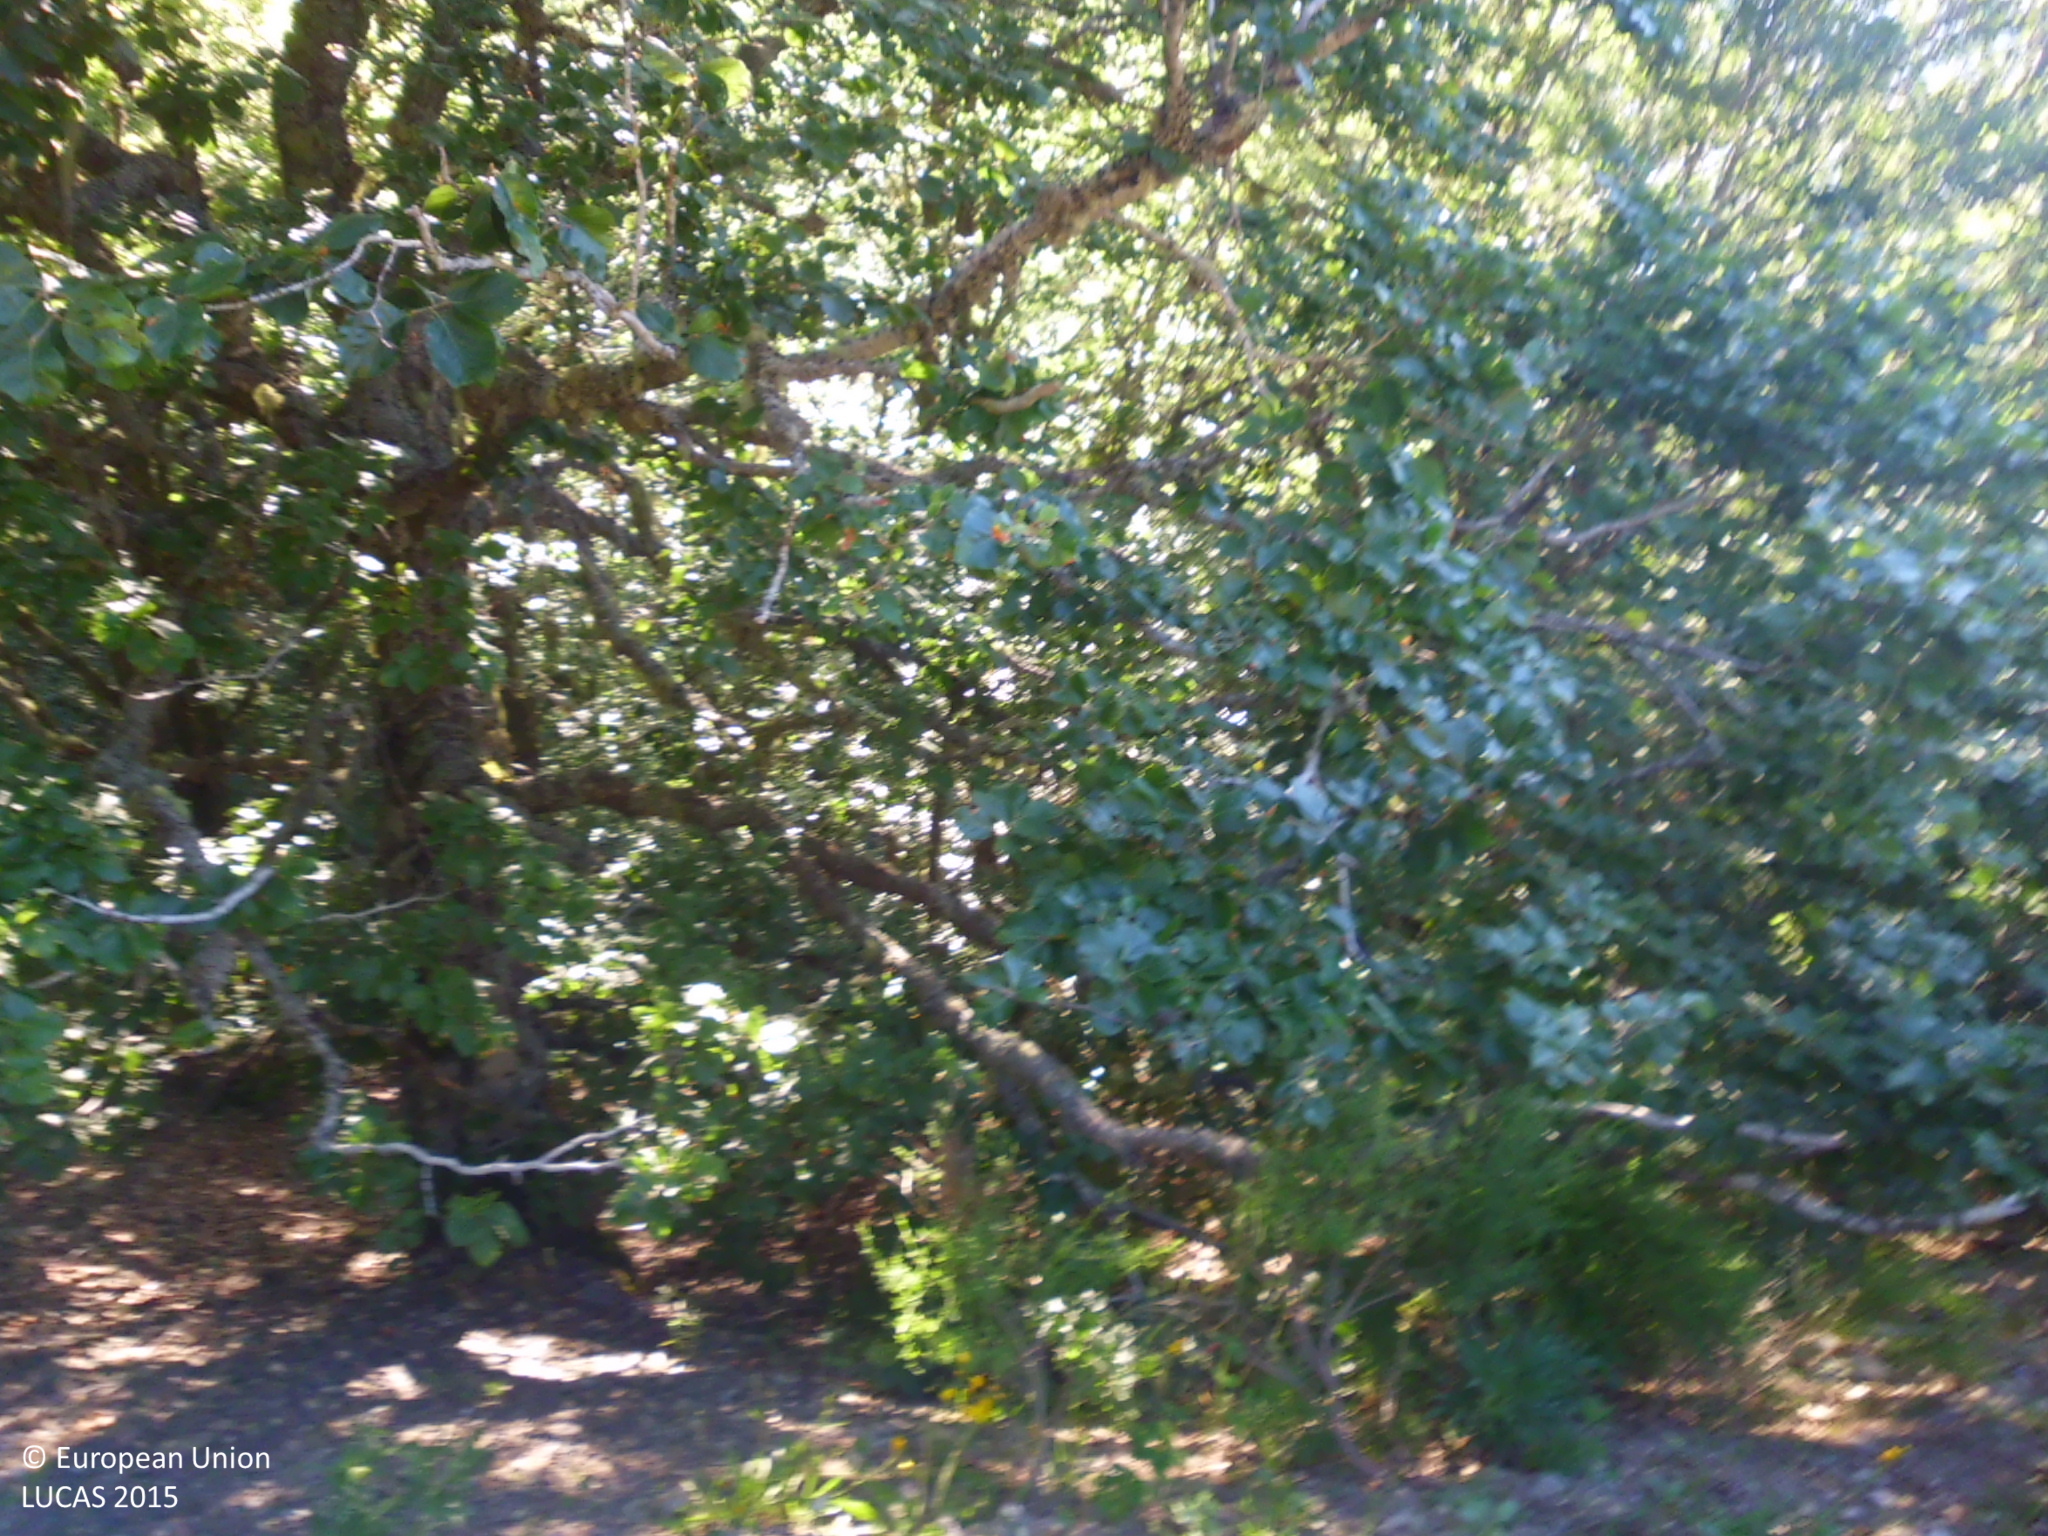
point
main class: Woodland
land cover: Broadleaved woodland
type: acidophilous oak and oak-birch forest
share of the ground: > 75 %
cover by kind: broadleaved forest trees 95 %, herbaceous plants 5 %
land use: Semi-natural and natural areas not in use
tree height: > 5 m
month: June
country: ES
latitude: 42.9303
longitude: -4.9514
